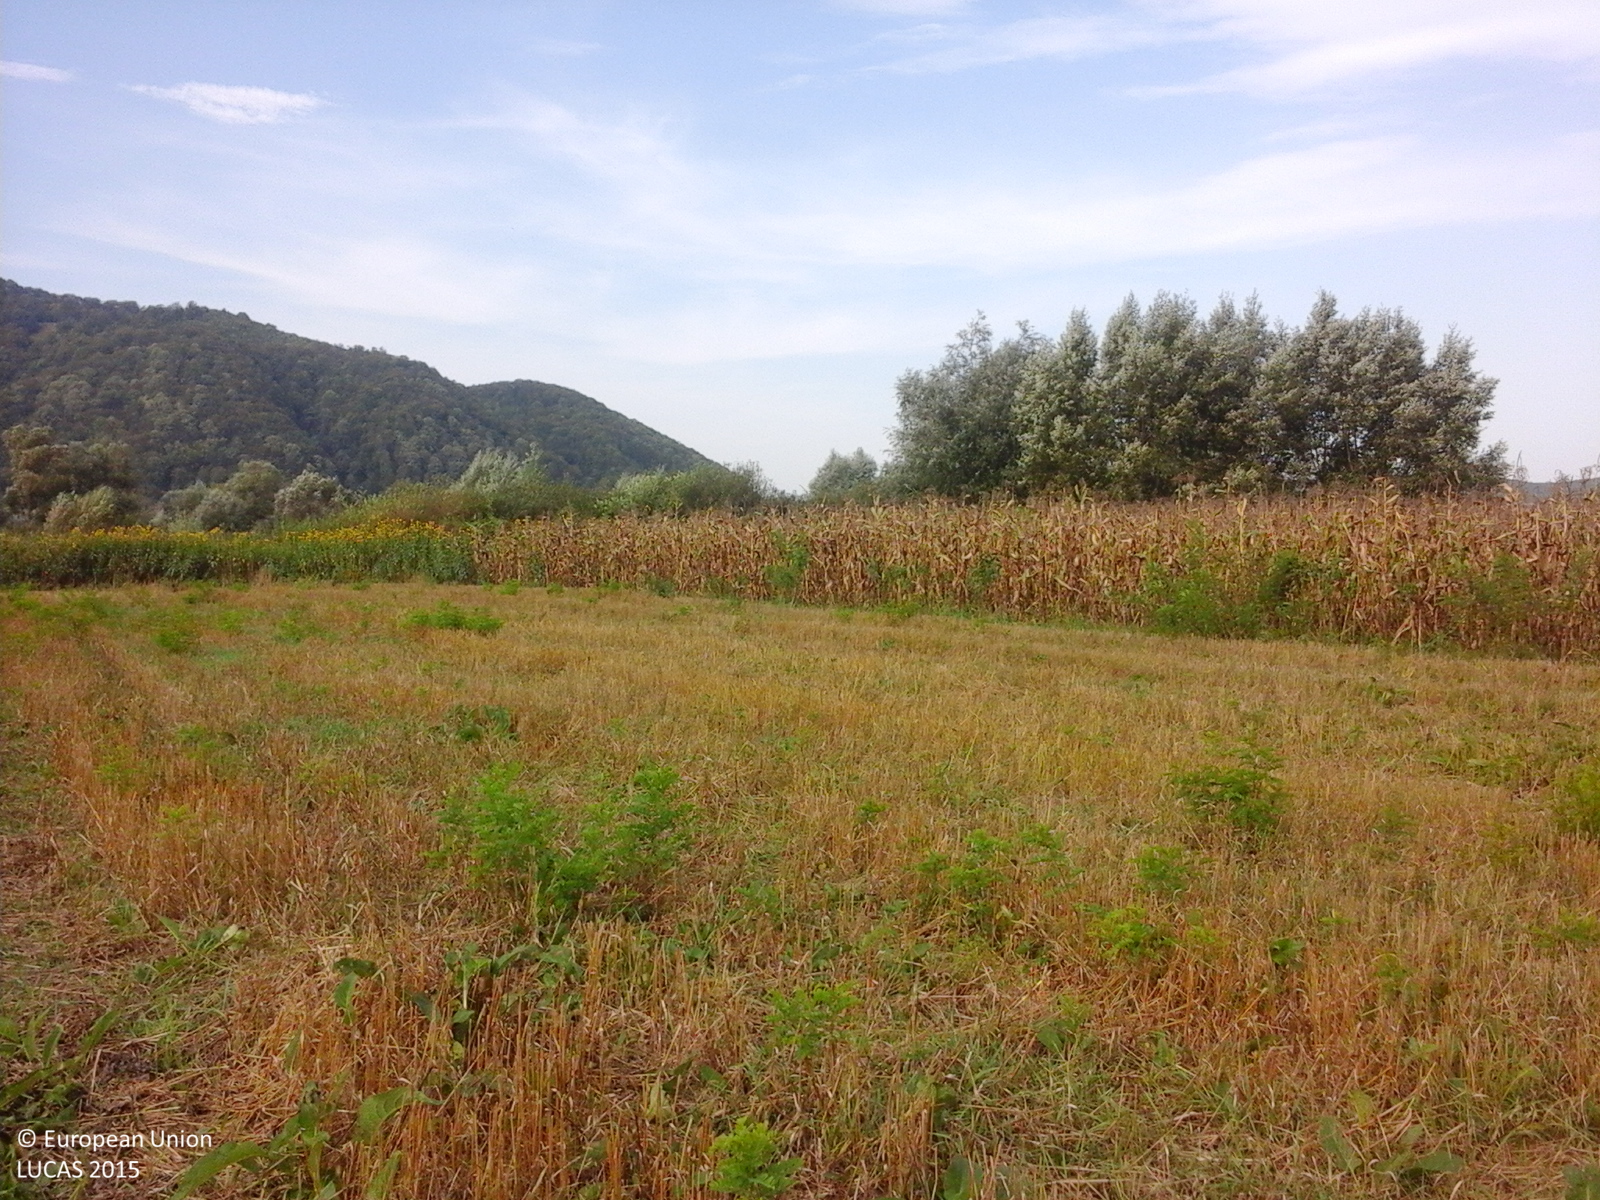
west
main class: Cropland
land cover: Oats
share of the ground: 25 - 50 %
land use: Agriculture (excluding fallow land and kitchen gardens)
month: September
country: RO
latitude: 47.2781
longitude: 23.6519
